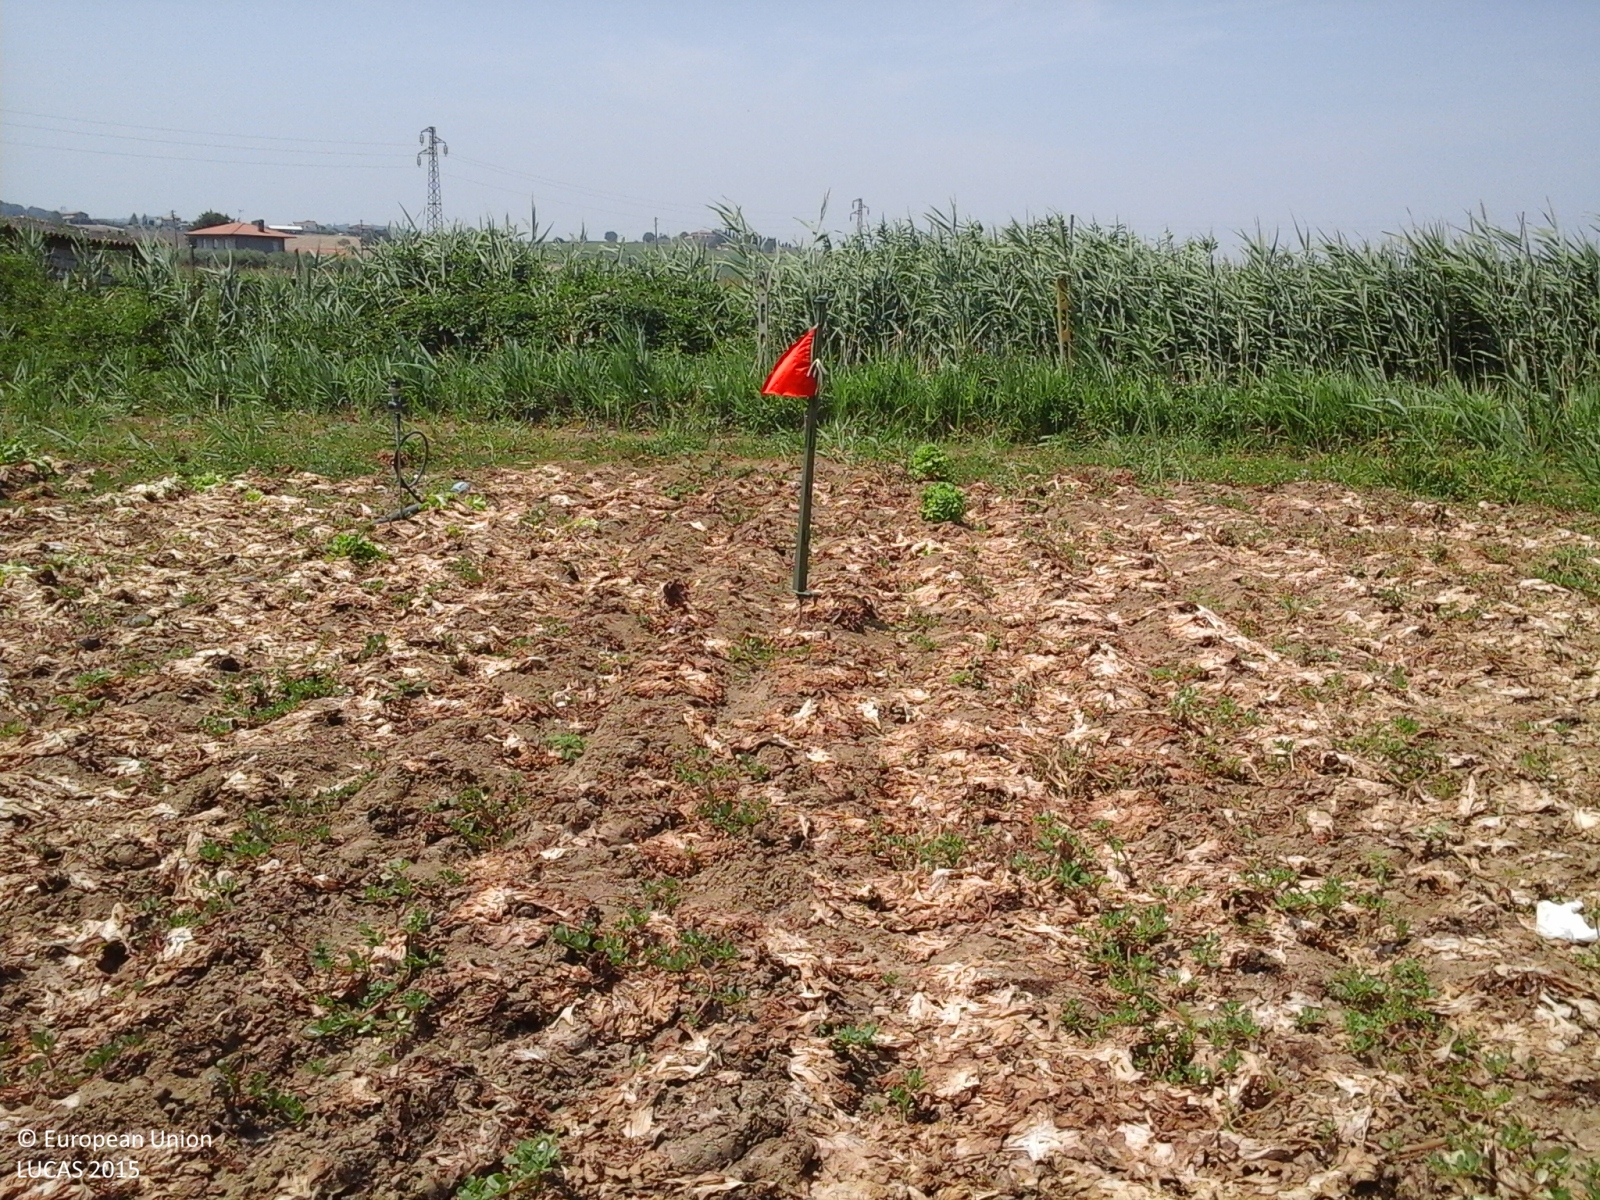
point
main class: Cropland
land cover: Other fresh vegetables
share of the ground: < 10 %
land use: Agriculture (excluding fallow land and kitchen gardens)
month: July
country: IT
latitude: 44.0701
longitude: 12.4042
